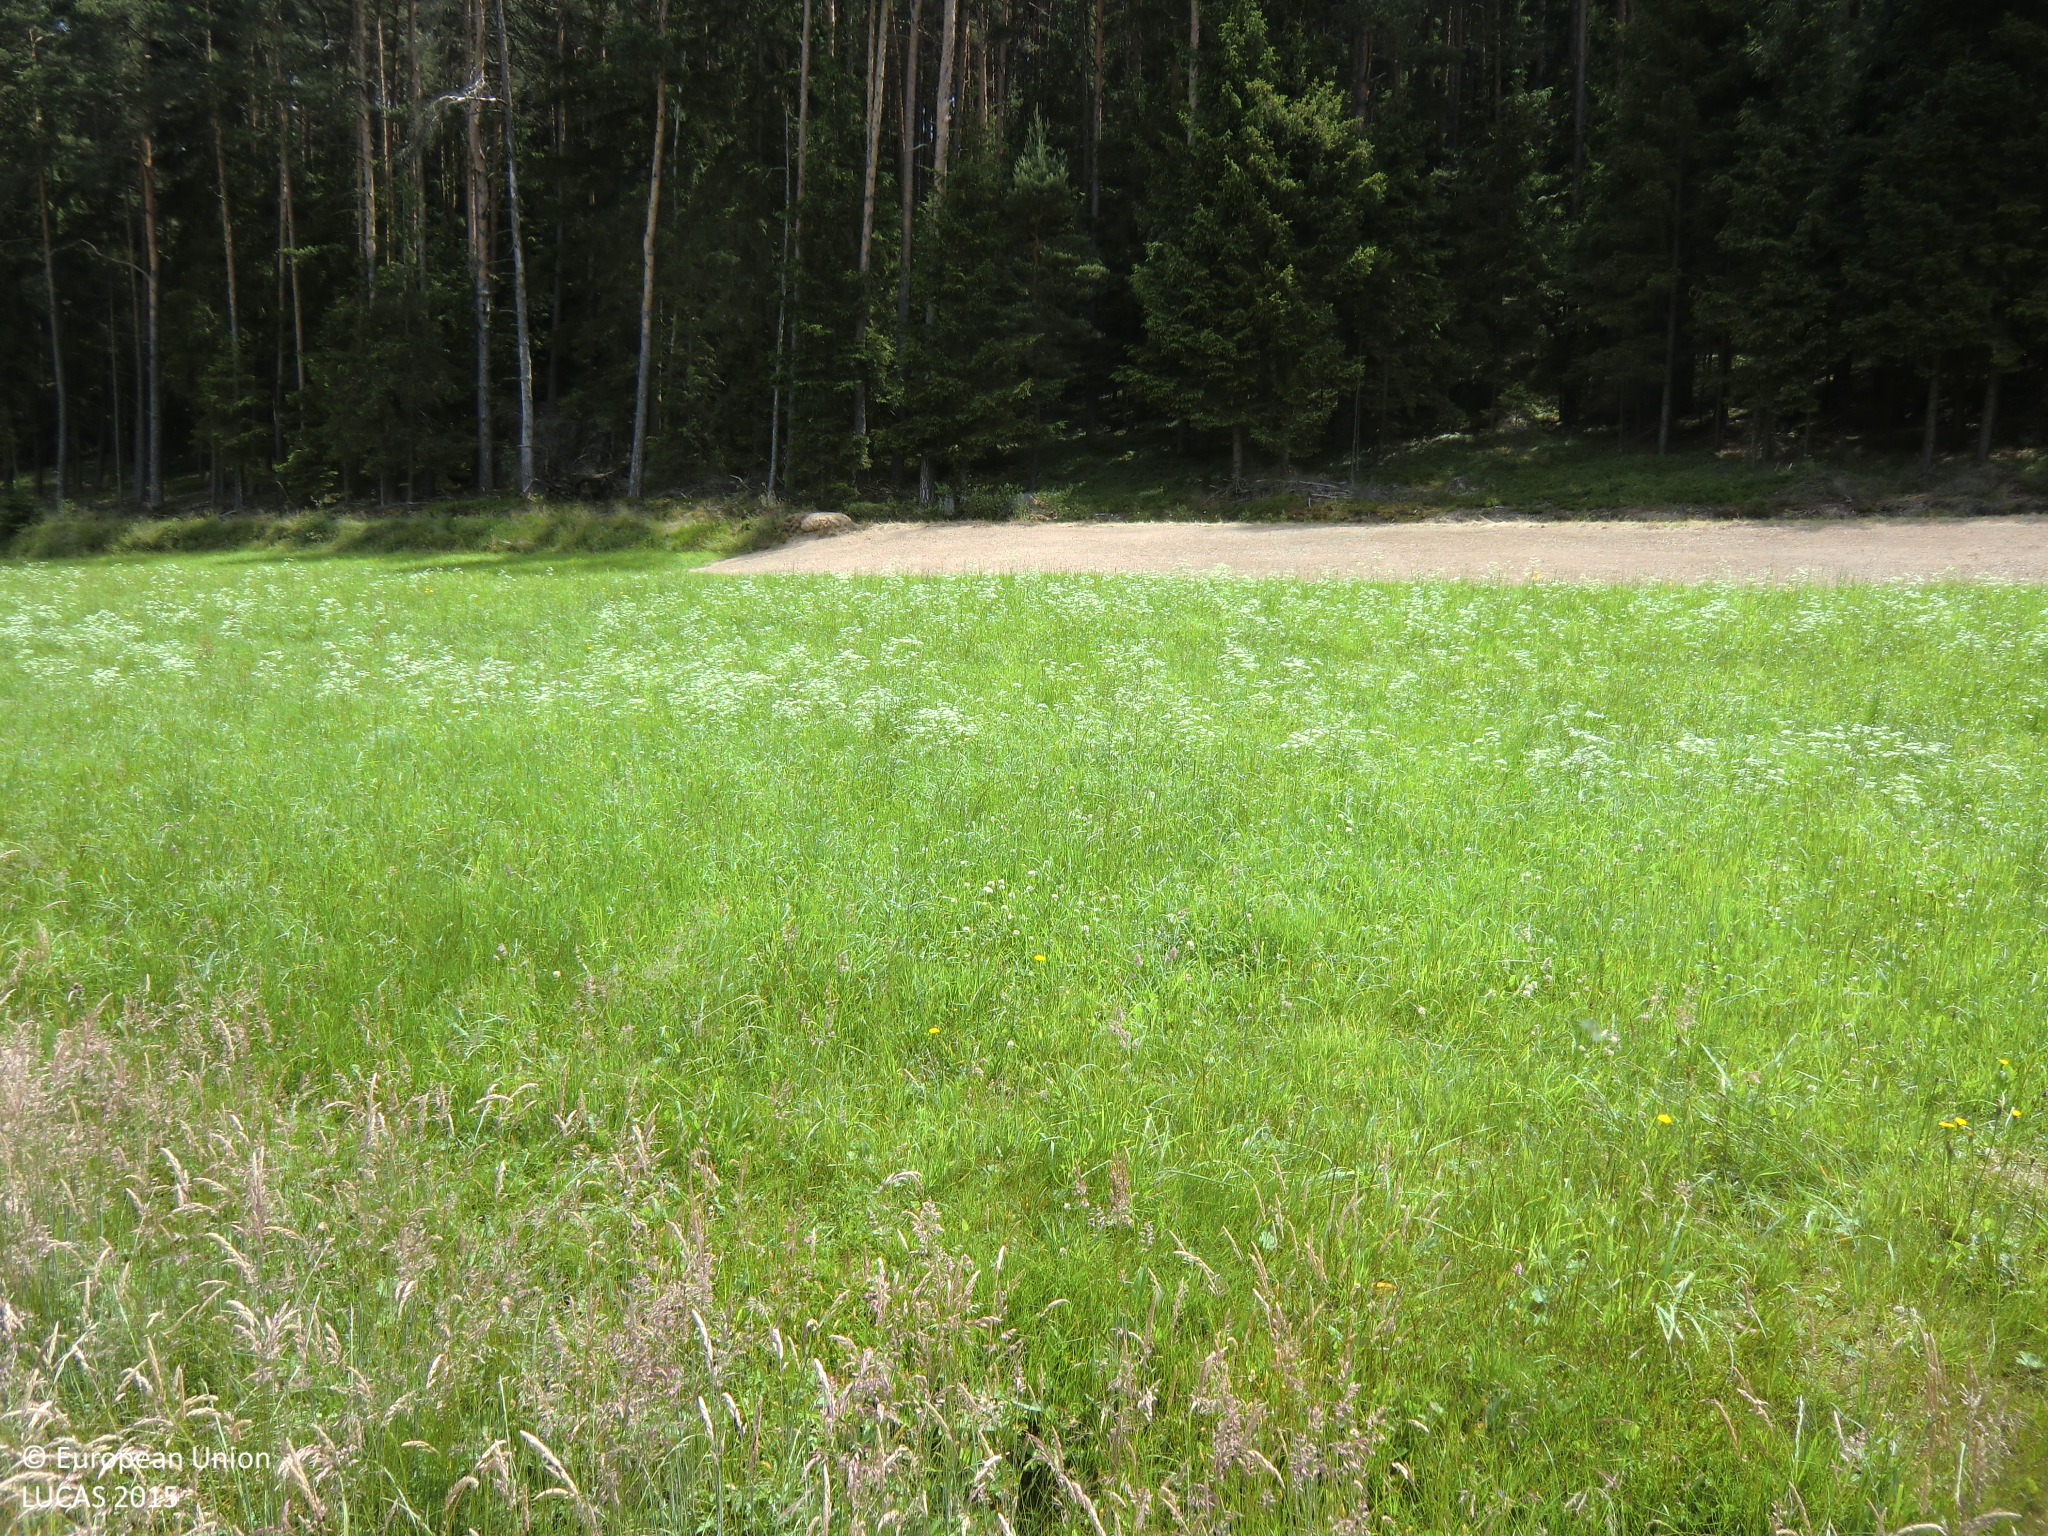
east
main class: Grassland
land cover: Grassland without tree/shrub cover
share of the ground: > 75 %
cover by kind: herbaceous plants 100 %
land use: Agriculture (excluding fallow land and kitchen gardens)
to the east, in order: Grassland without tree/shrub cover; Ditches and canals; Grassland without tree/shrub cover; Other bare soil; Tracks; Pine dominated coniferous woodland; Tracks; Pine dominated coniferous woodland
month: June
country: AT
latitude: 48.4865
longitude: 15.0484
